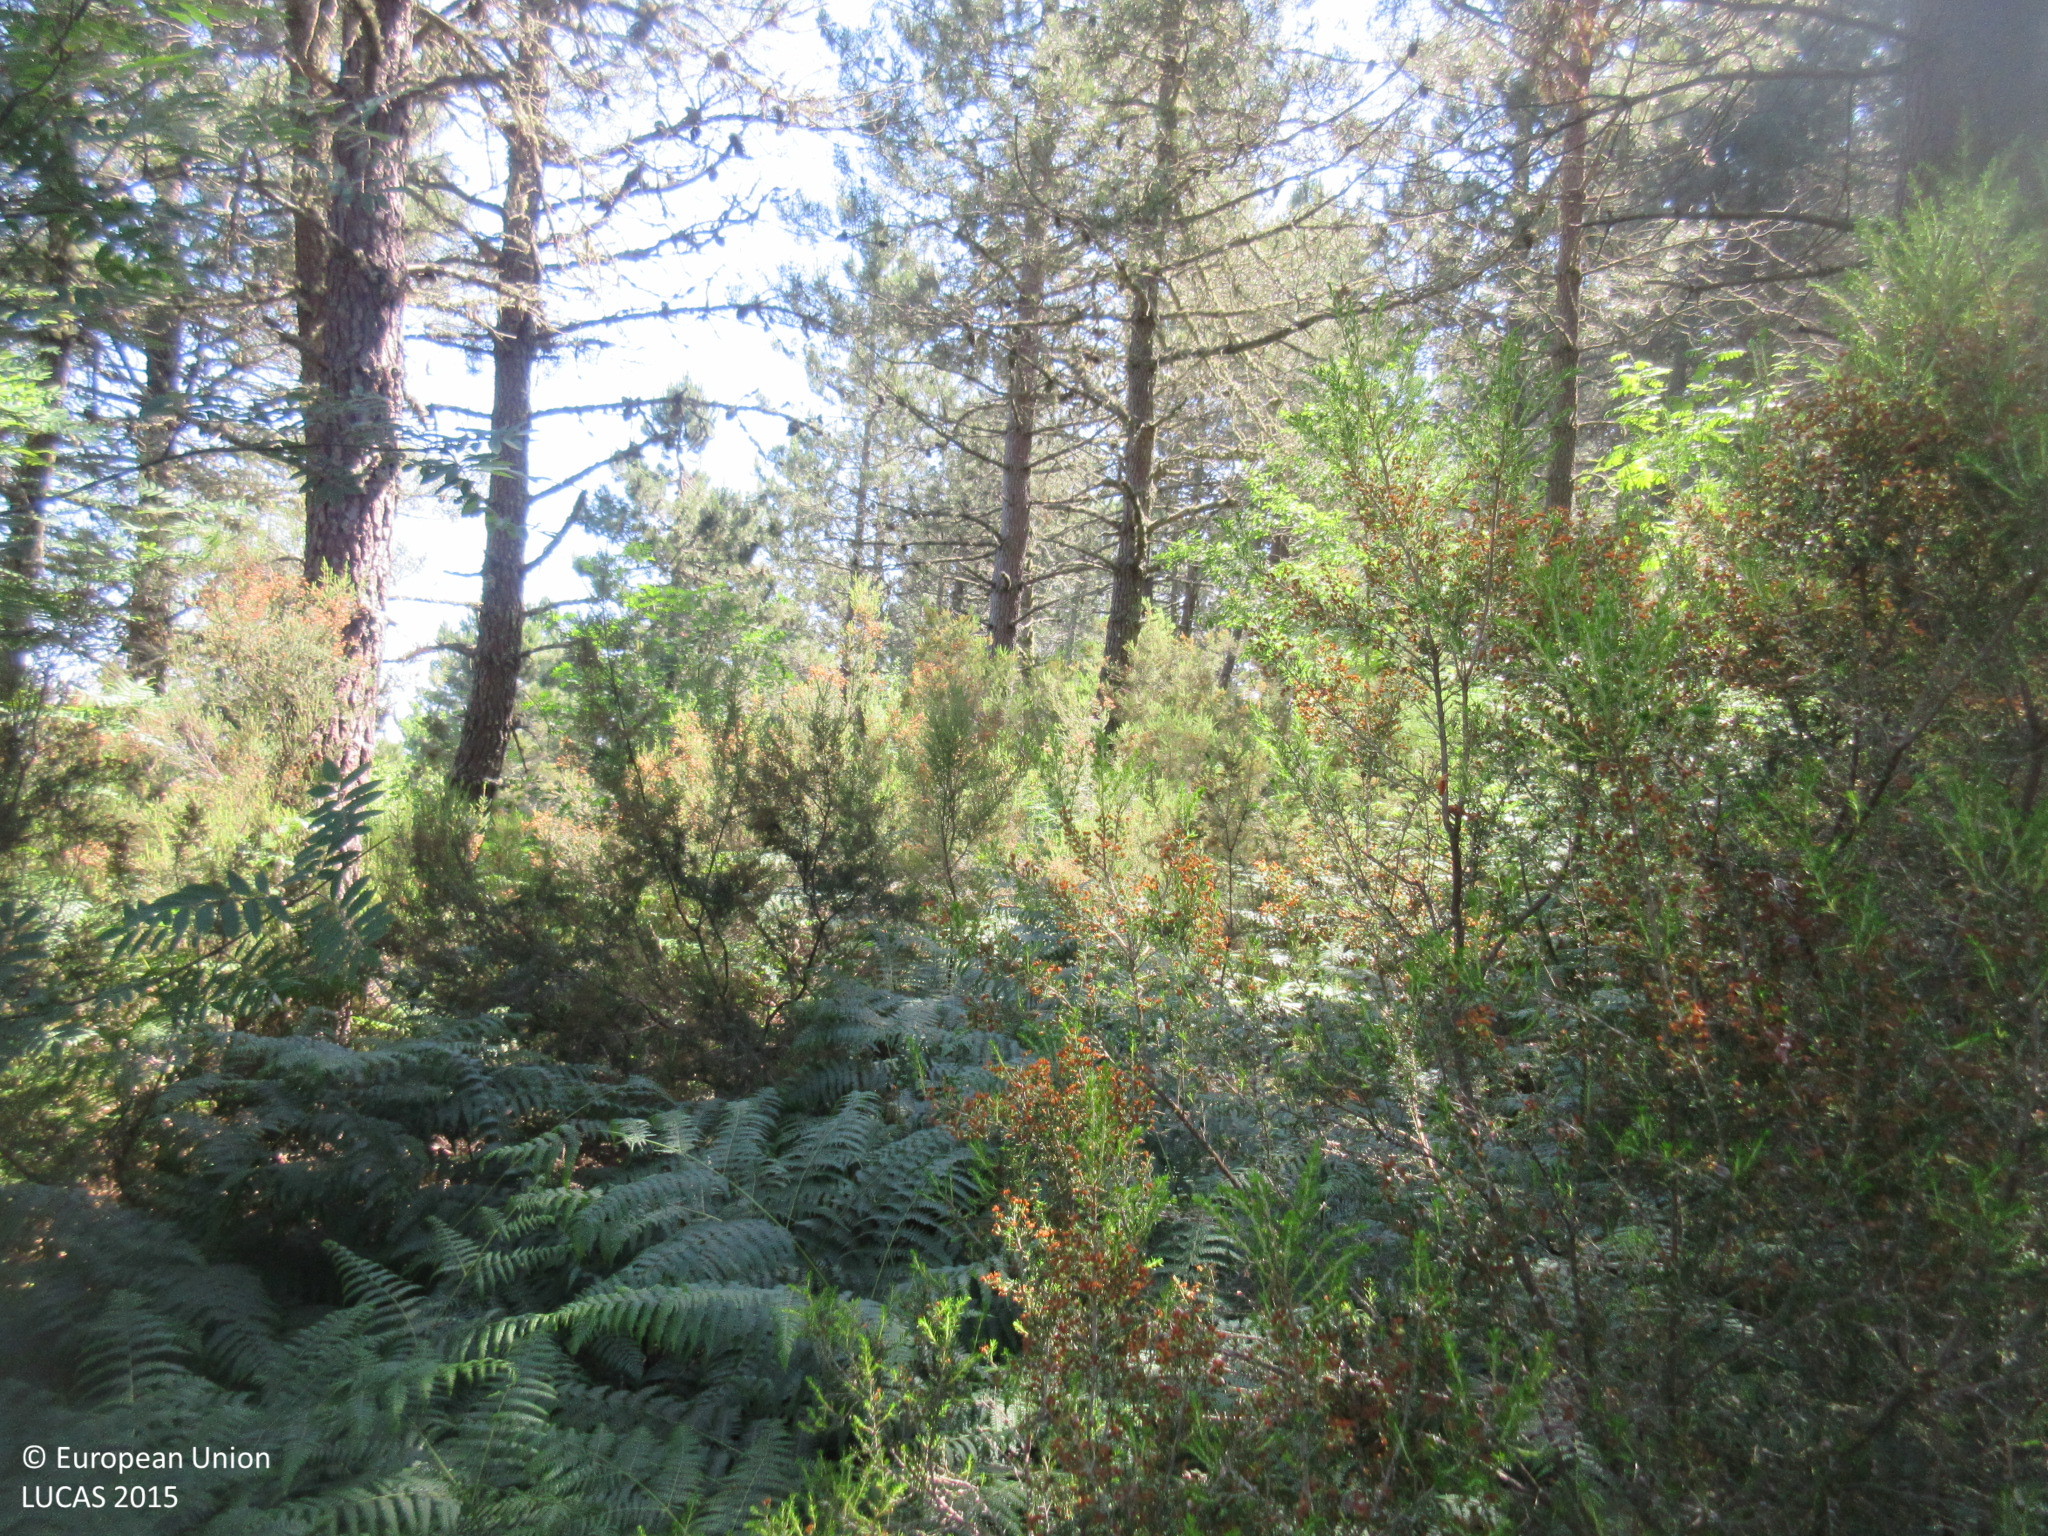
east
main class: Woodland
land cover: Pine dominated coniferous woodland
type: hemiboreal forest and nemoral coniferous forest and mixed broadleaved-coniferous forest
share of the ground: > 75 %
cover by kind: coniferous forest trees 95 %, shrubs 5 %
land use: Forestry
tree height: > 5 m
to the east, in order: Pine dominated coniferous woodland
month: June
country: ES
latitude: 42.9244
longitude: -6.9552
